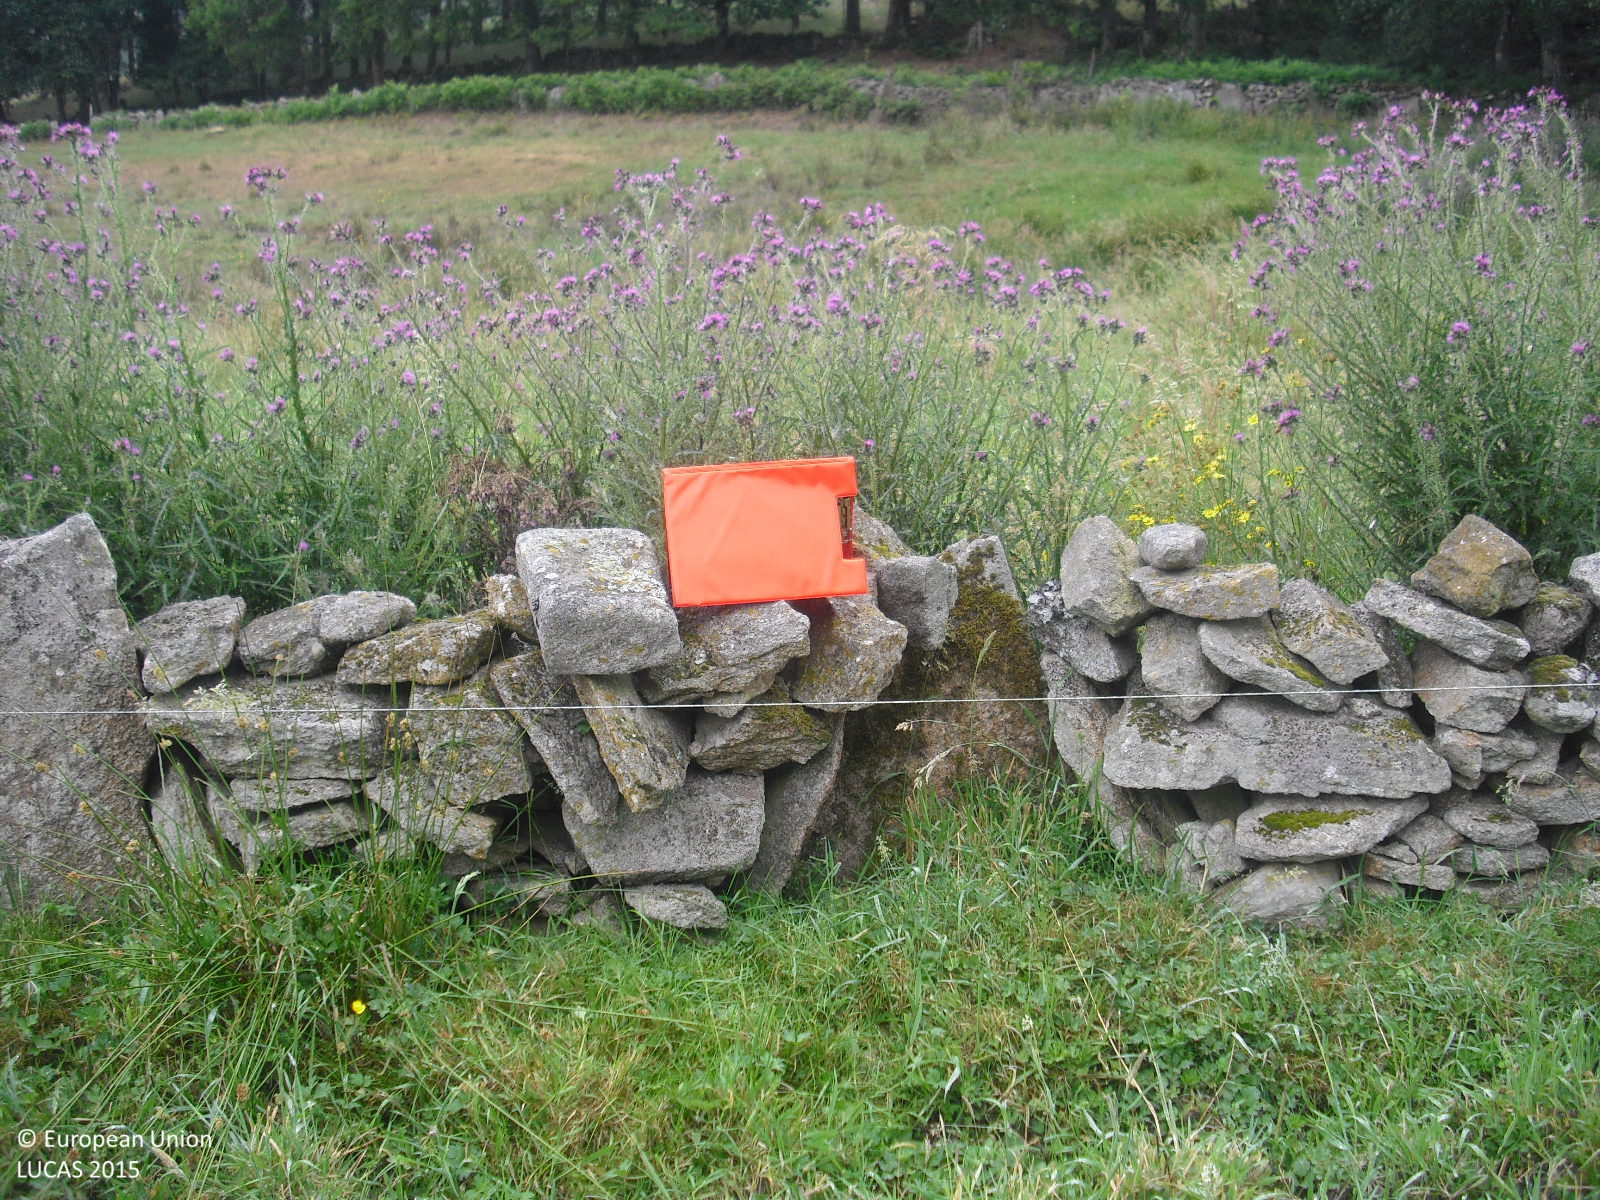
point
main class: Grassland
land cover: Grassland without tree/shrub cover
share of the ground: > 75 %
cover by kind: herbaceous plants 100 %
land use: Agriculture (excluding fallow land and kitchen gardens)
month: June
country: ES
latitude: 42.6927
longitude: -7.9667
